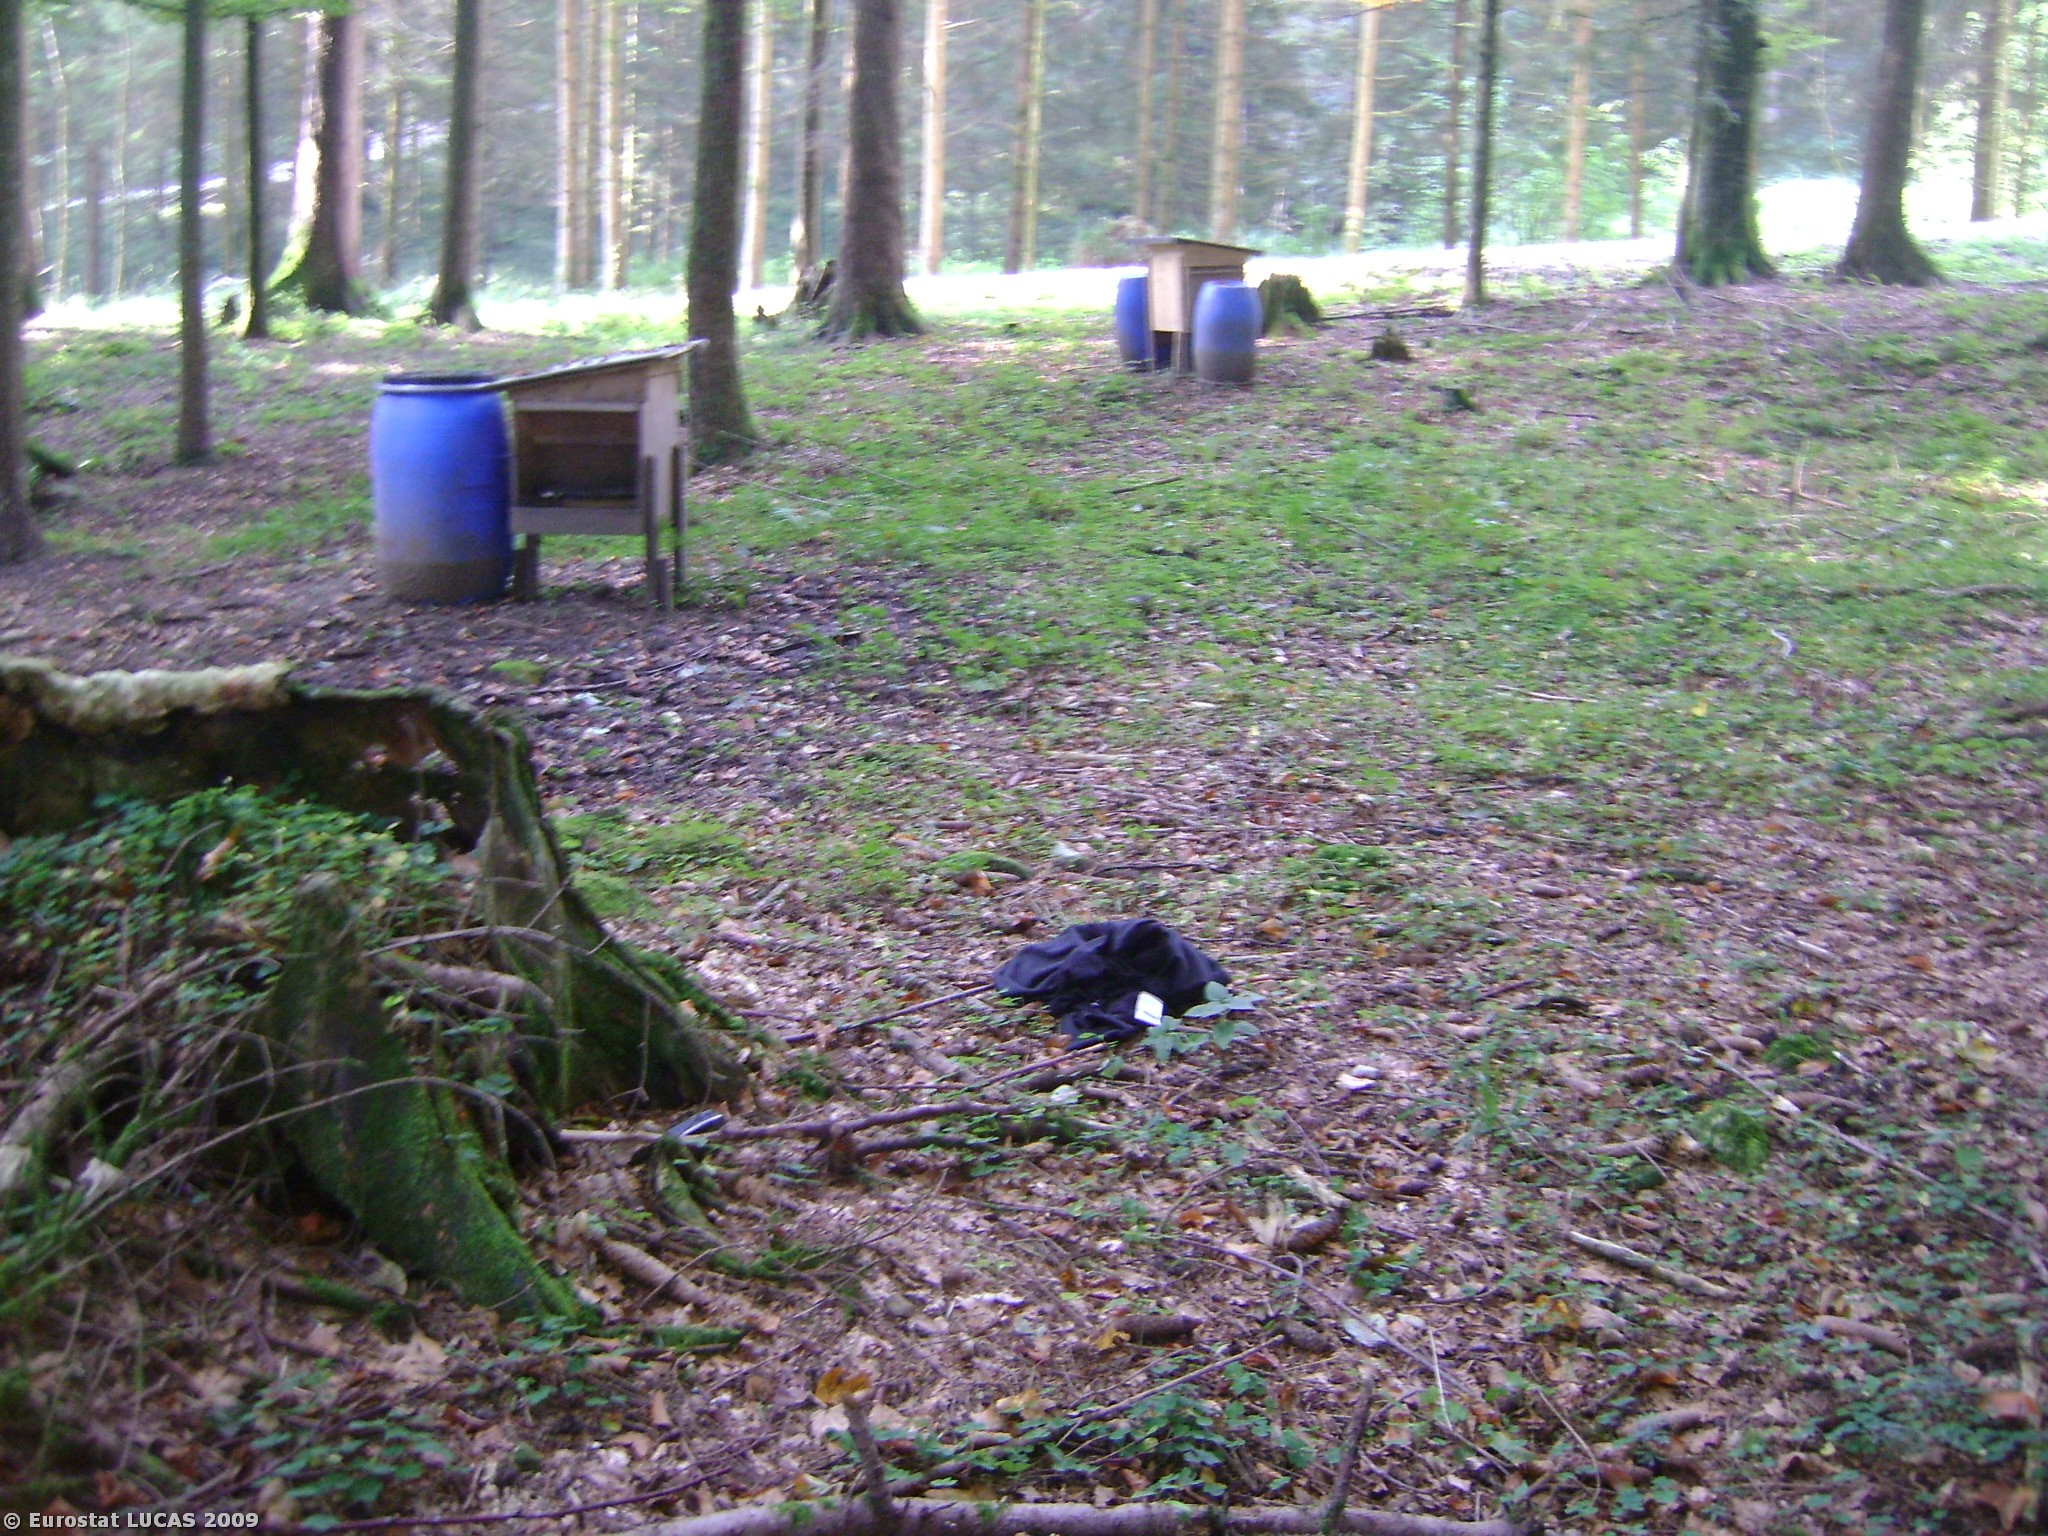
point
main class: Woodland
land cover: Mixed woodland
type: hemiboreal forest and nemoral coniferous forest and mixed broadleaved-coniferous forest
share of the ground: > 75 %
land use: Forestry
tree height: > 5 m
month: September
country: AT
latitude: 47.8680
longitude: 13.3008
